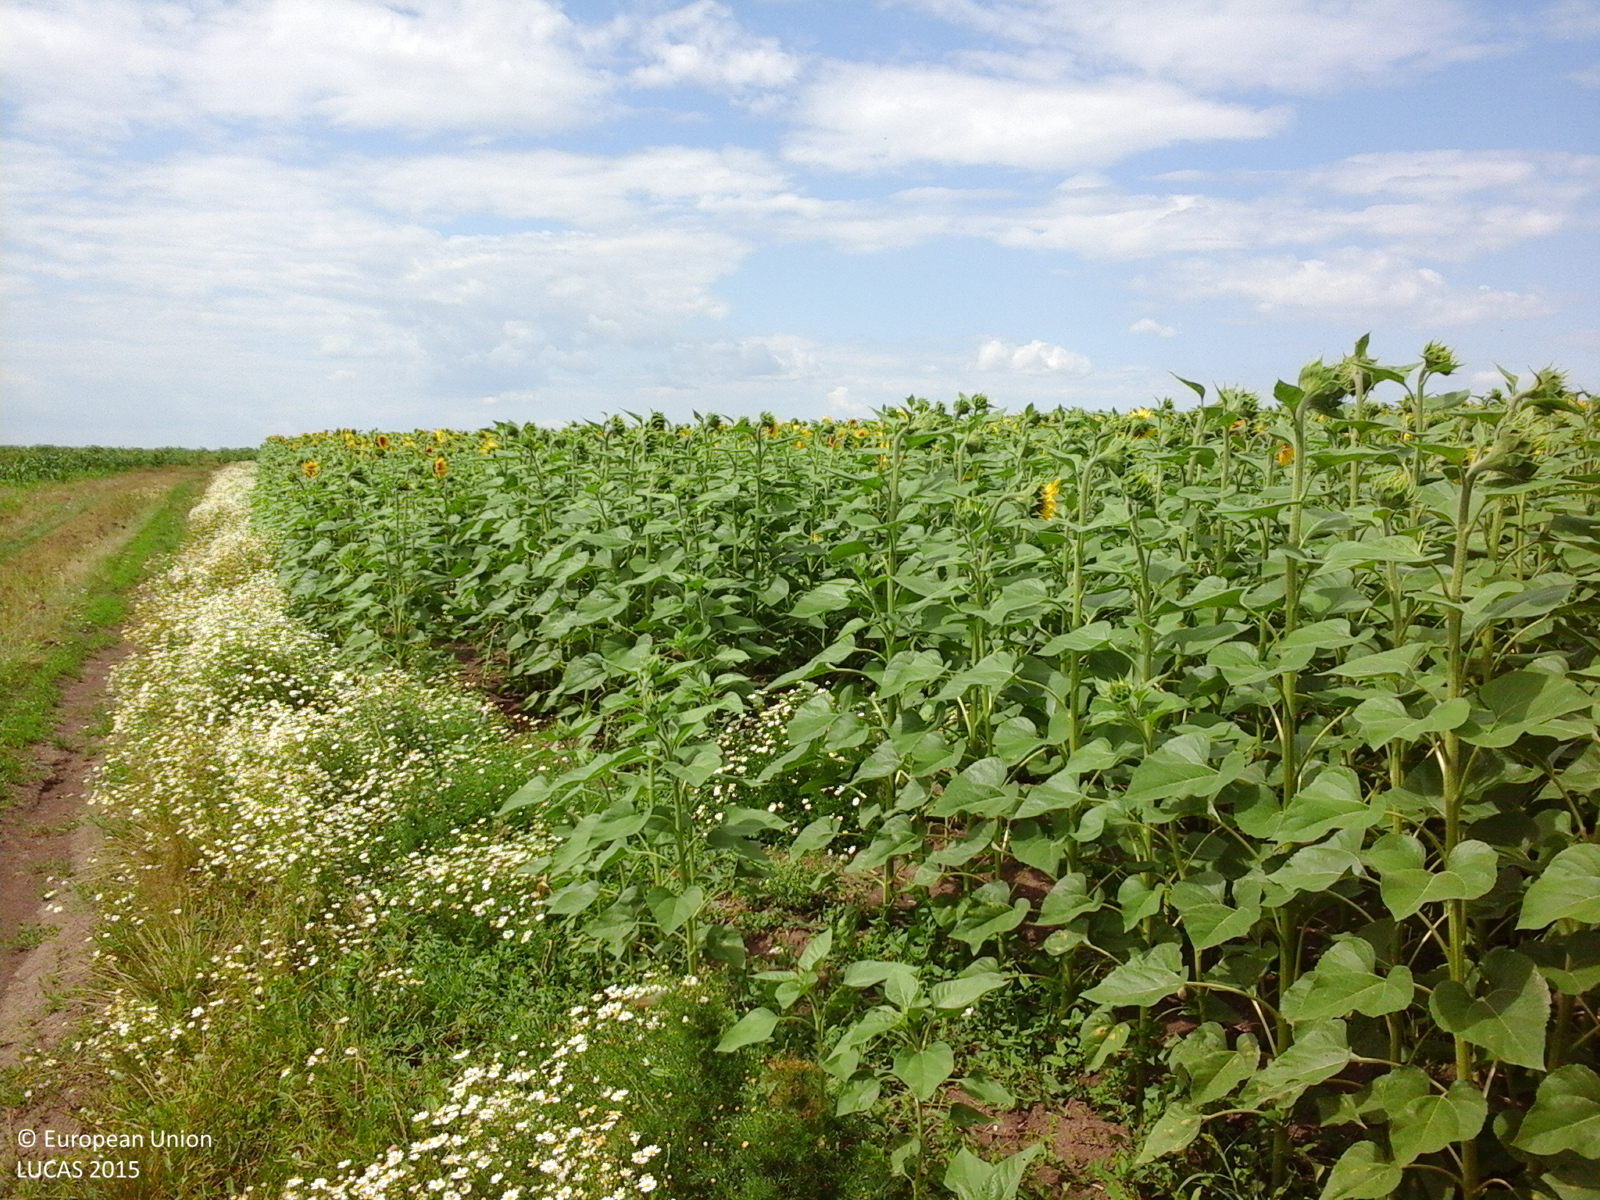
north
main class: Cropland
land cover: Sunflower
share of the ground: > 75 %
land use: Agriculture (excluding fallow land and kitchen gardens)
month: July
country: RO
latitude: 44.3530
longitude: 24.7401
